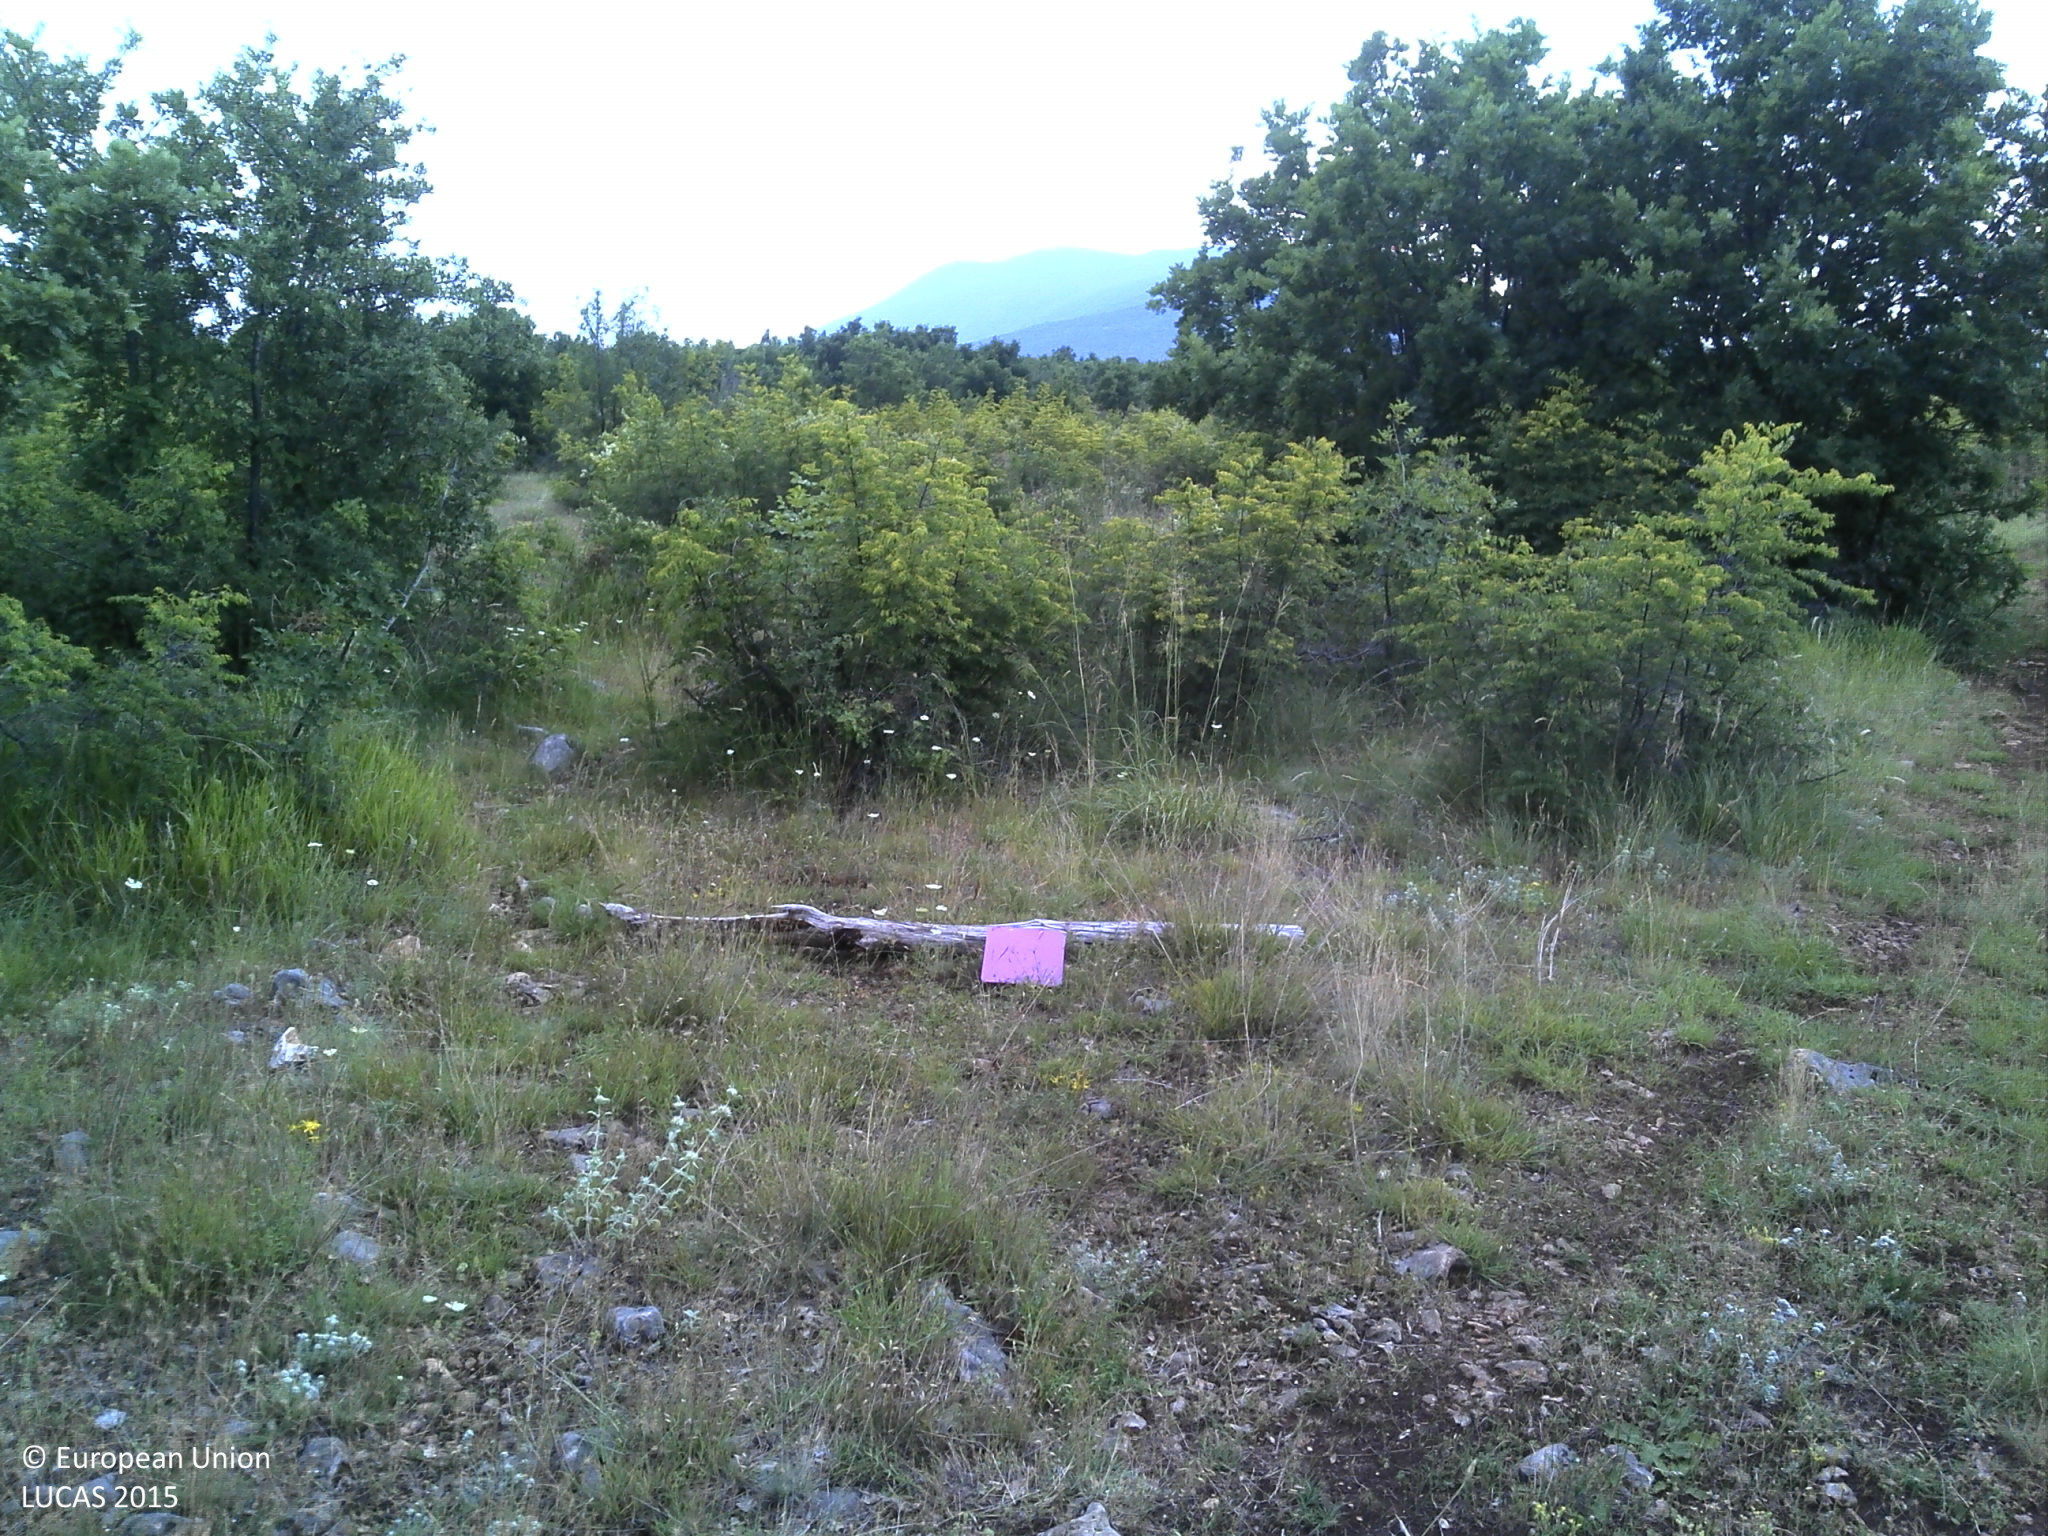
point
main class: Shrubland
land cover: Shrubland with sparse tree cover
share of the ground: 50 - 75 %
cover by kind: shrubs 45 %, herbaceous plants 45 %, broadleaved forest trees 5 %, unconsolidated bare surface 5 %
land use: Semi-natural and natural areas not in use
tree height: < 5 m
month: June
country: HR
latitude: 44.0059
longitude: 16.1411
